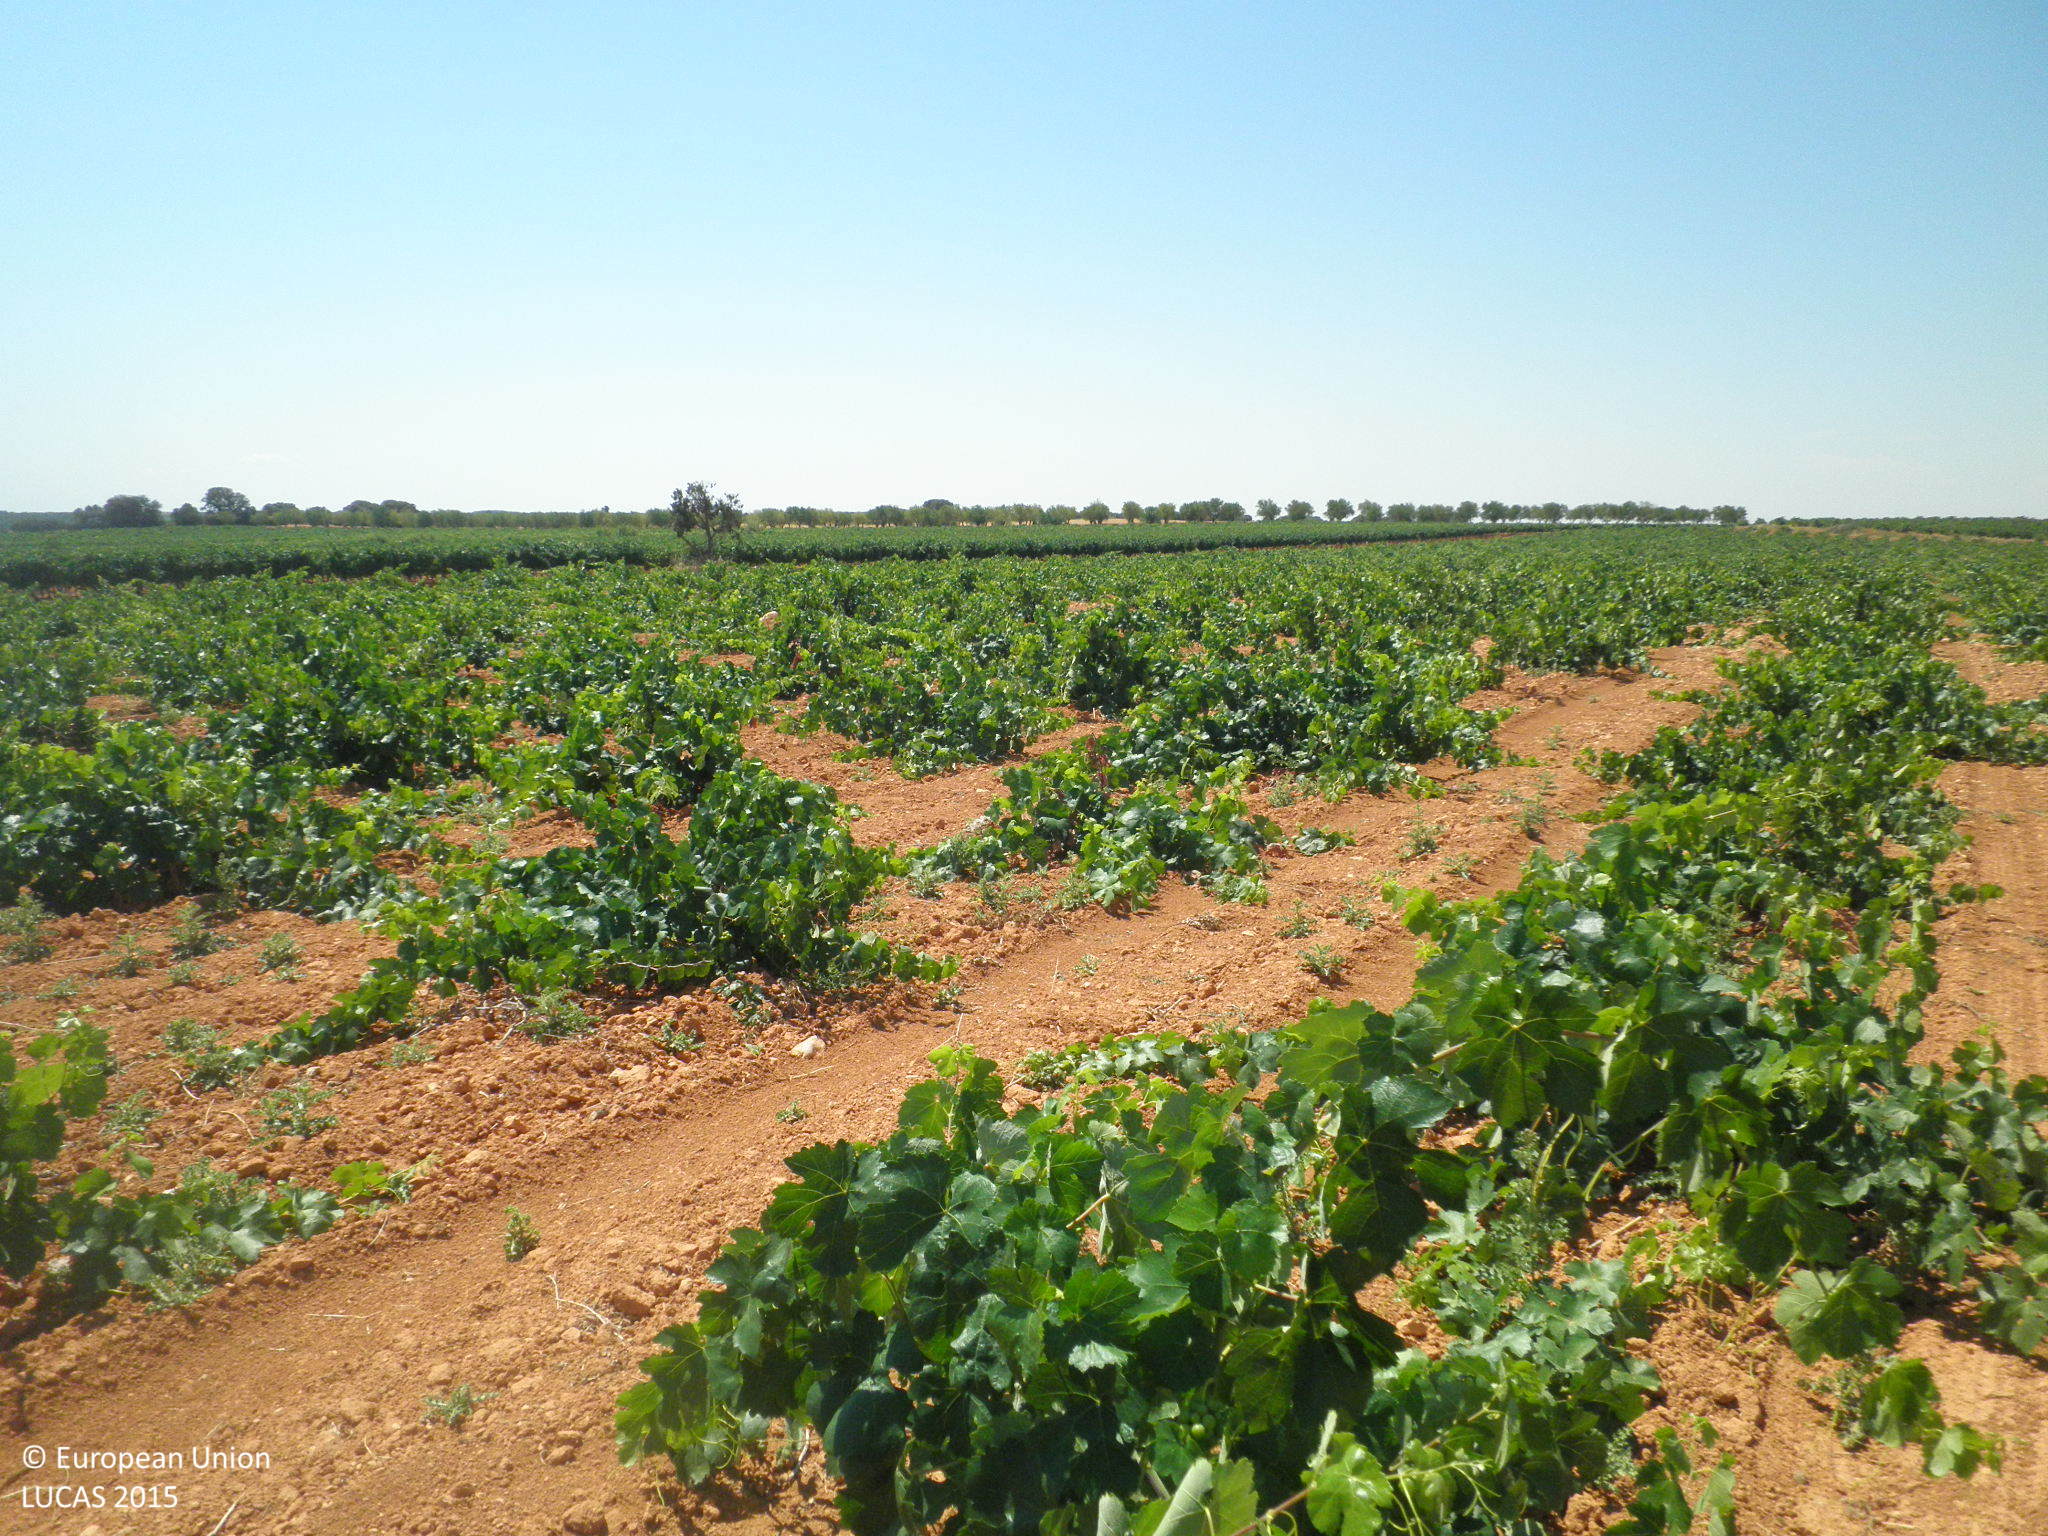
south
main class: Cropland
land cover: Vineyards
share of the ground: 10 - 25 %
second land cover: Other bare soil
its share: > 75 %
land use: Agriculture (excluding fallow land and kitchen gardens)
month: July
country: ES
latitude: 39.5877
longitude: -1.6614
